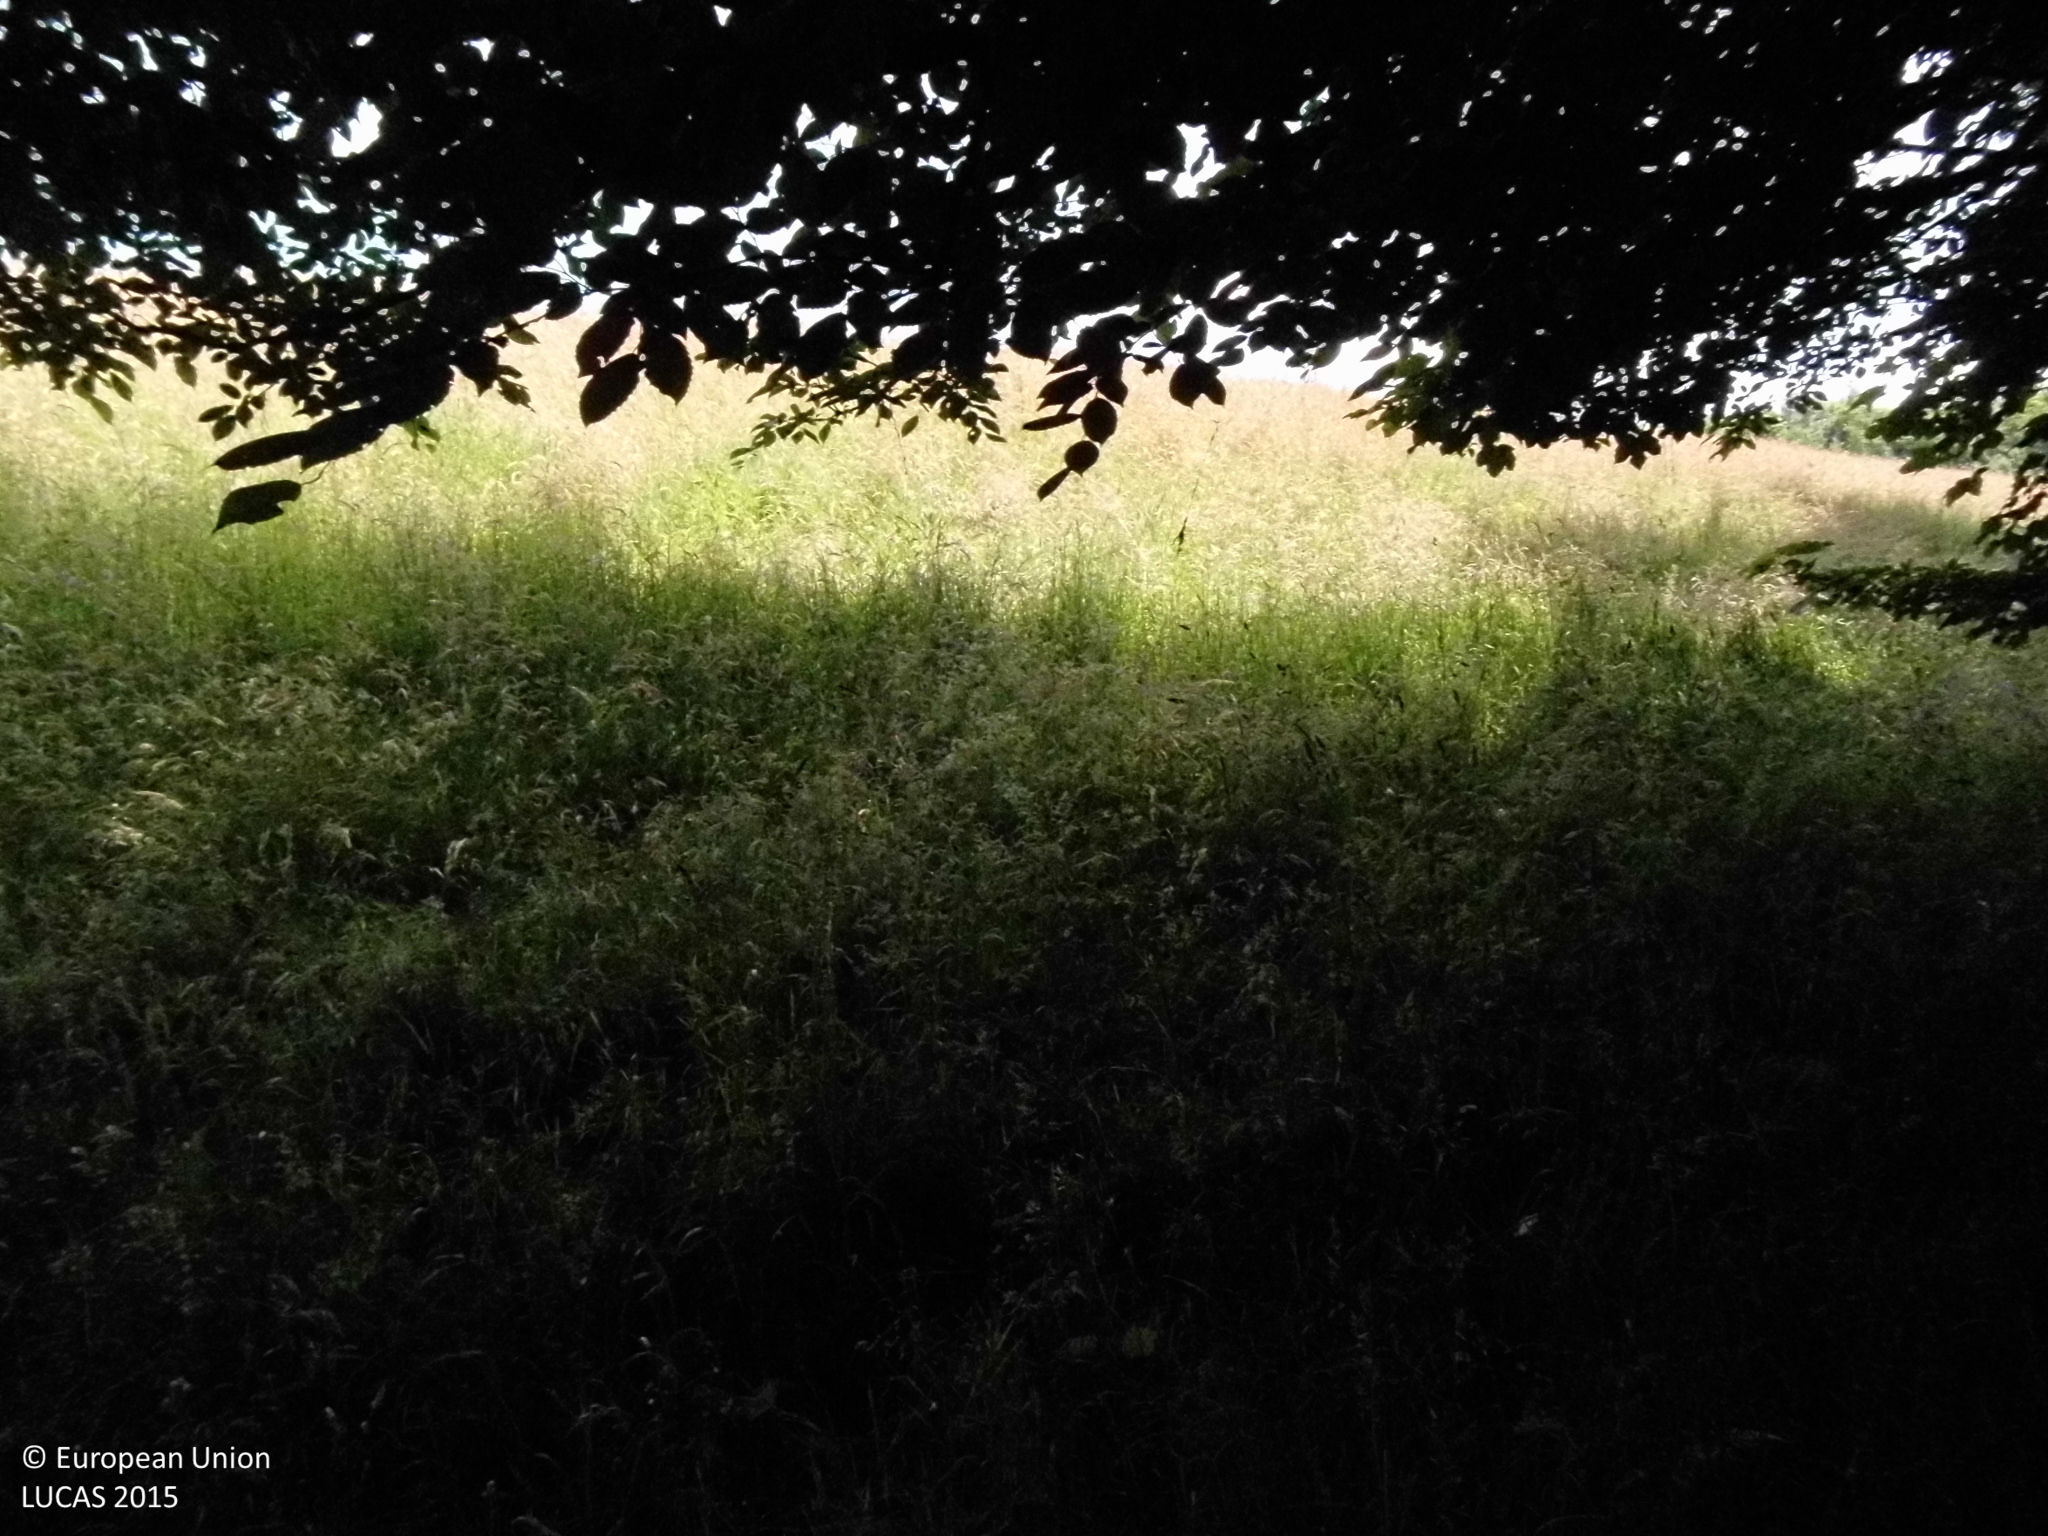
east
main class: Woodland
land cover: Broadleaved woodland
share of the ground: > 75 %
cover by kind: broadleaved forest trees 100 %
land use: Semi-natural and natural areas not in use
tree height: > 5 m
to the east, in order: Broadleaved woodland; Fences; Grassland without tree/shrub cover; Tracks; Grassland without tree/shrub cover; Maize; Grassland without tree/shrub cover
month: June
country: DE
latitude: 50.9826
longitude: 7.4220
